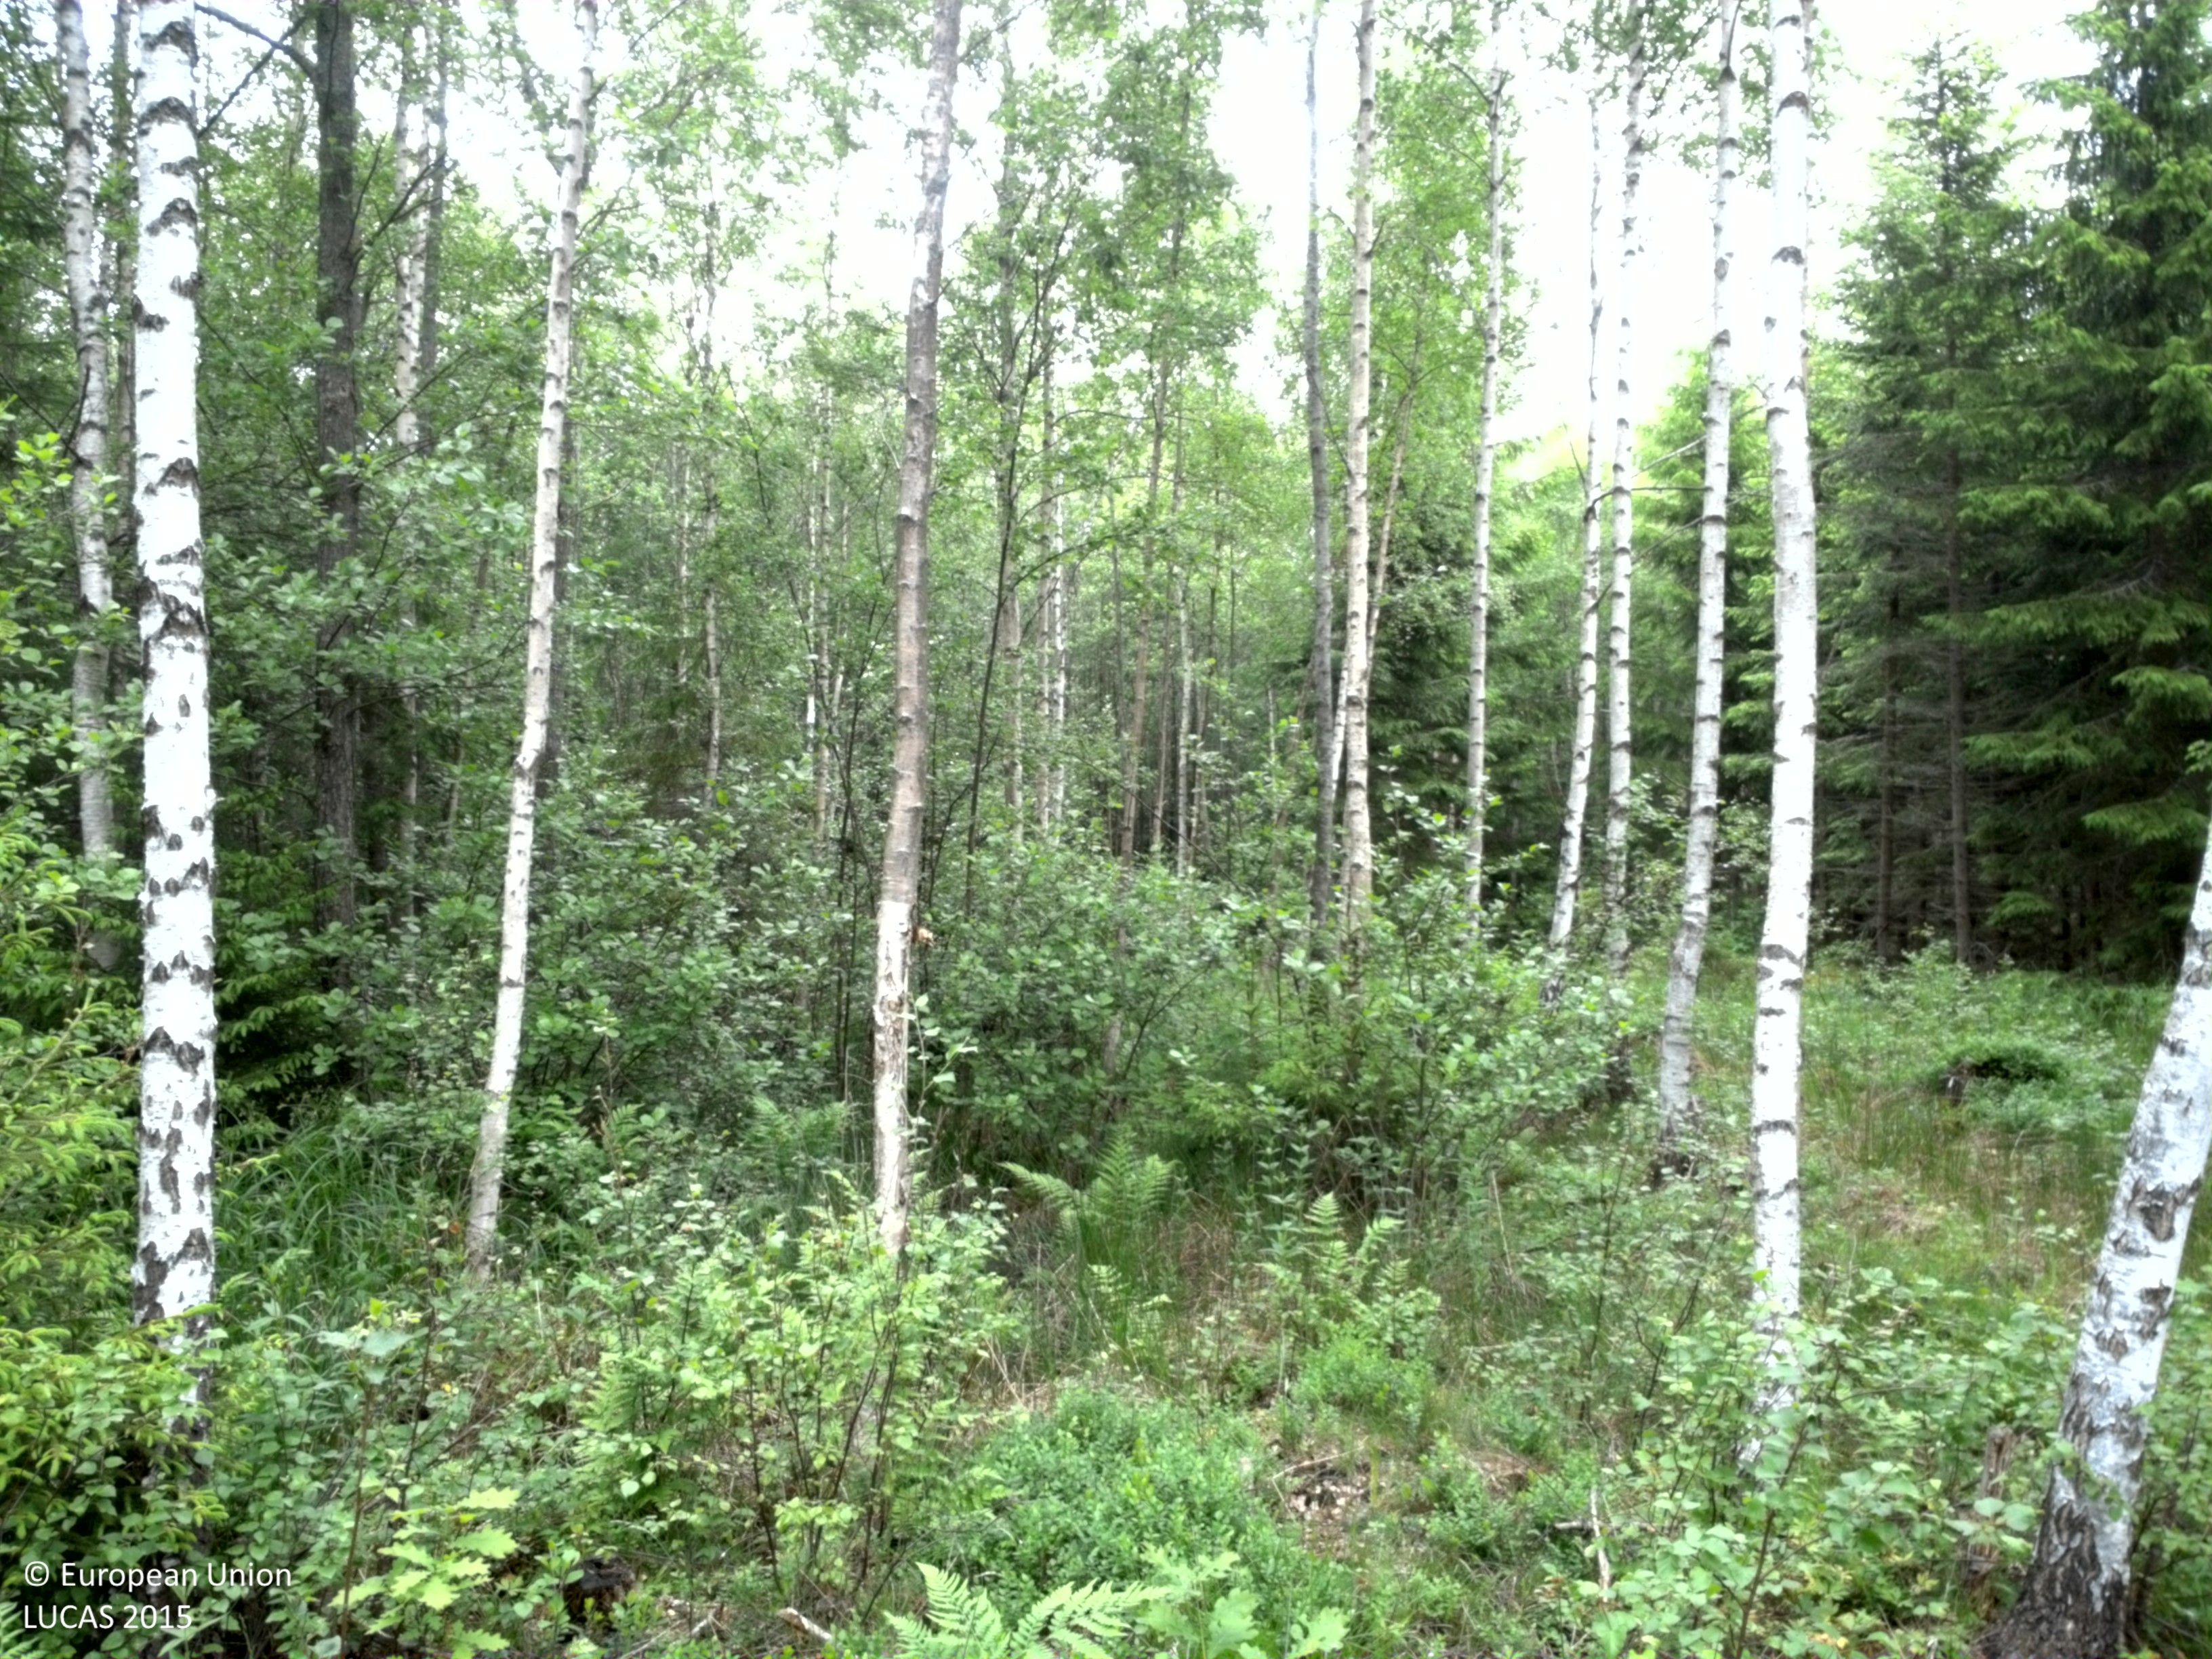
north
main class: Woodland
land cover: Spruce dominated mixed woodland
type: boreal forest
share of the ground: 50 - 75 %
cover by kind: coniferous forest trees 45 %, herbaceous plants 30 %, broadleaved forest trees 15 %, lichens and mosses 10 %
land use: Forestry
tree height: > 5 m
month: June
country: SE
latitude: 59.6905
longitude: 18.7586
